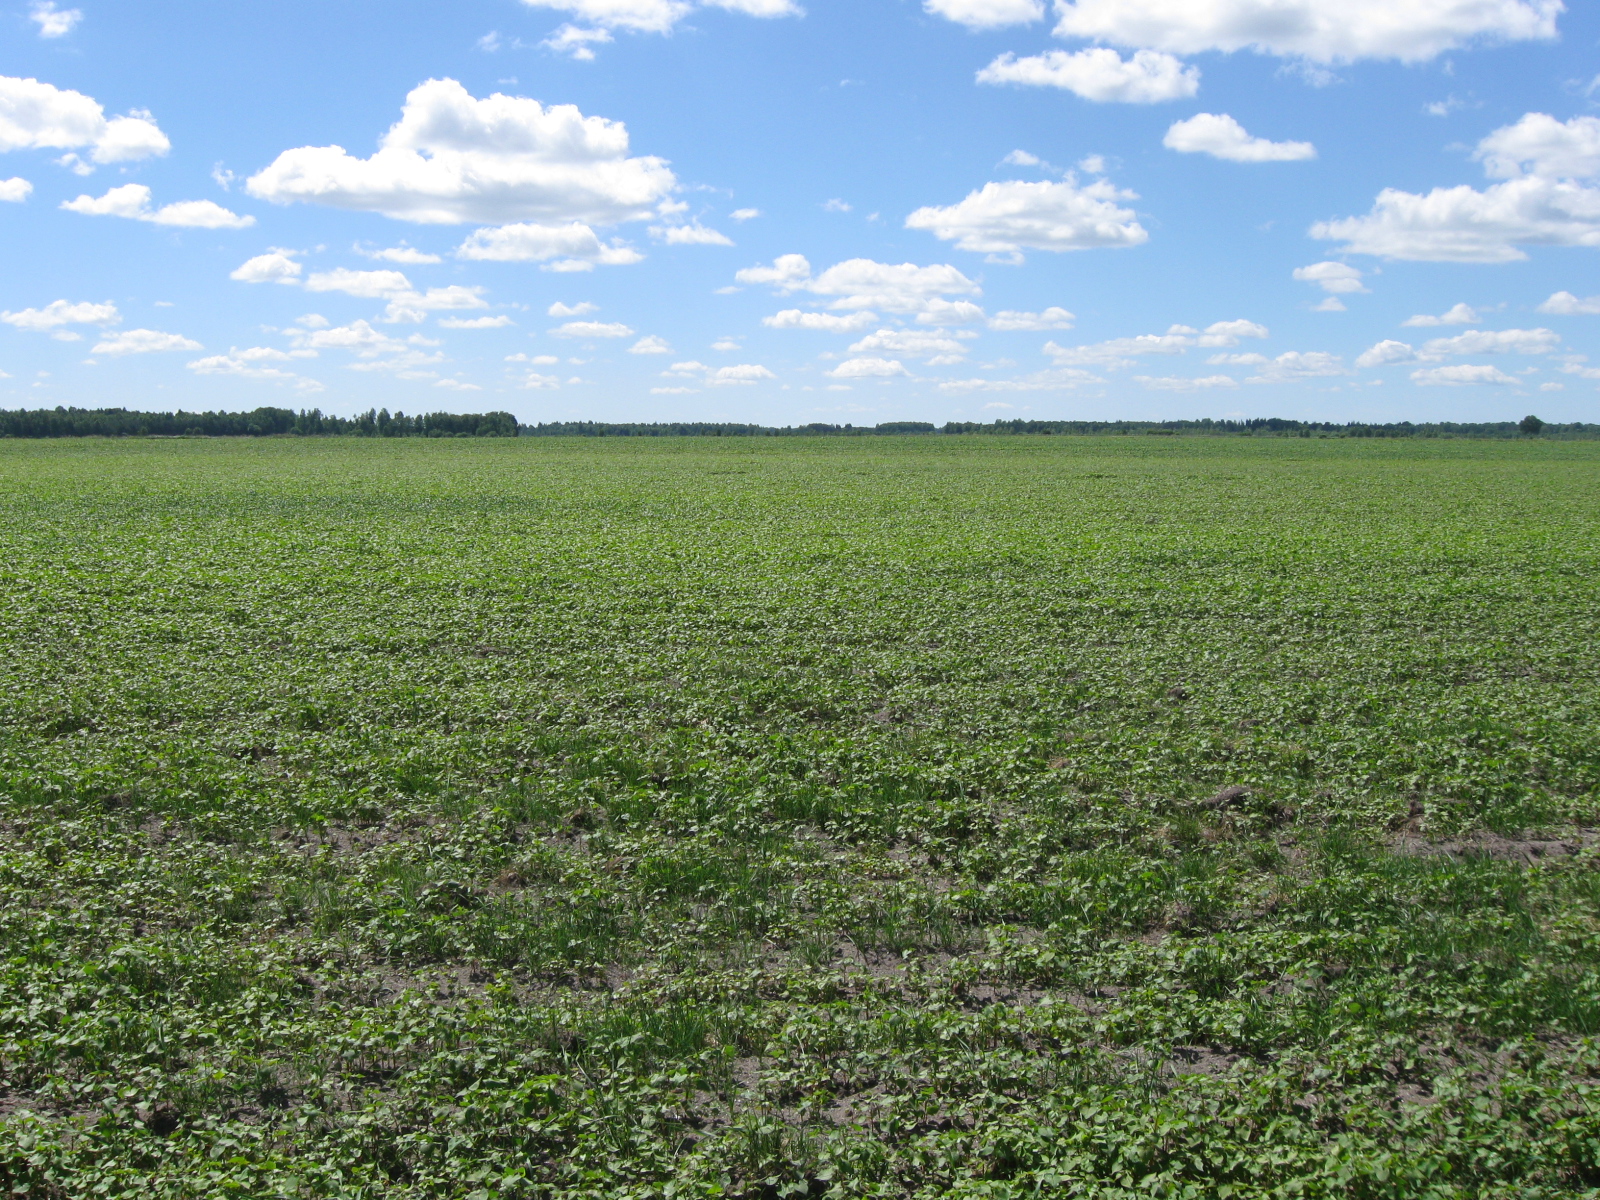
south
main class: Cropland
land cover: Other cereals
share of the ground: > 75 %
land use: Agriculture (excluding fallow land and kitchen gardens)
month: June
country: LT
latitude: 54.0149
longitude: 24.7138
